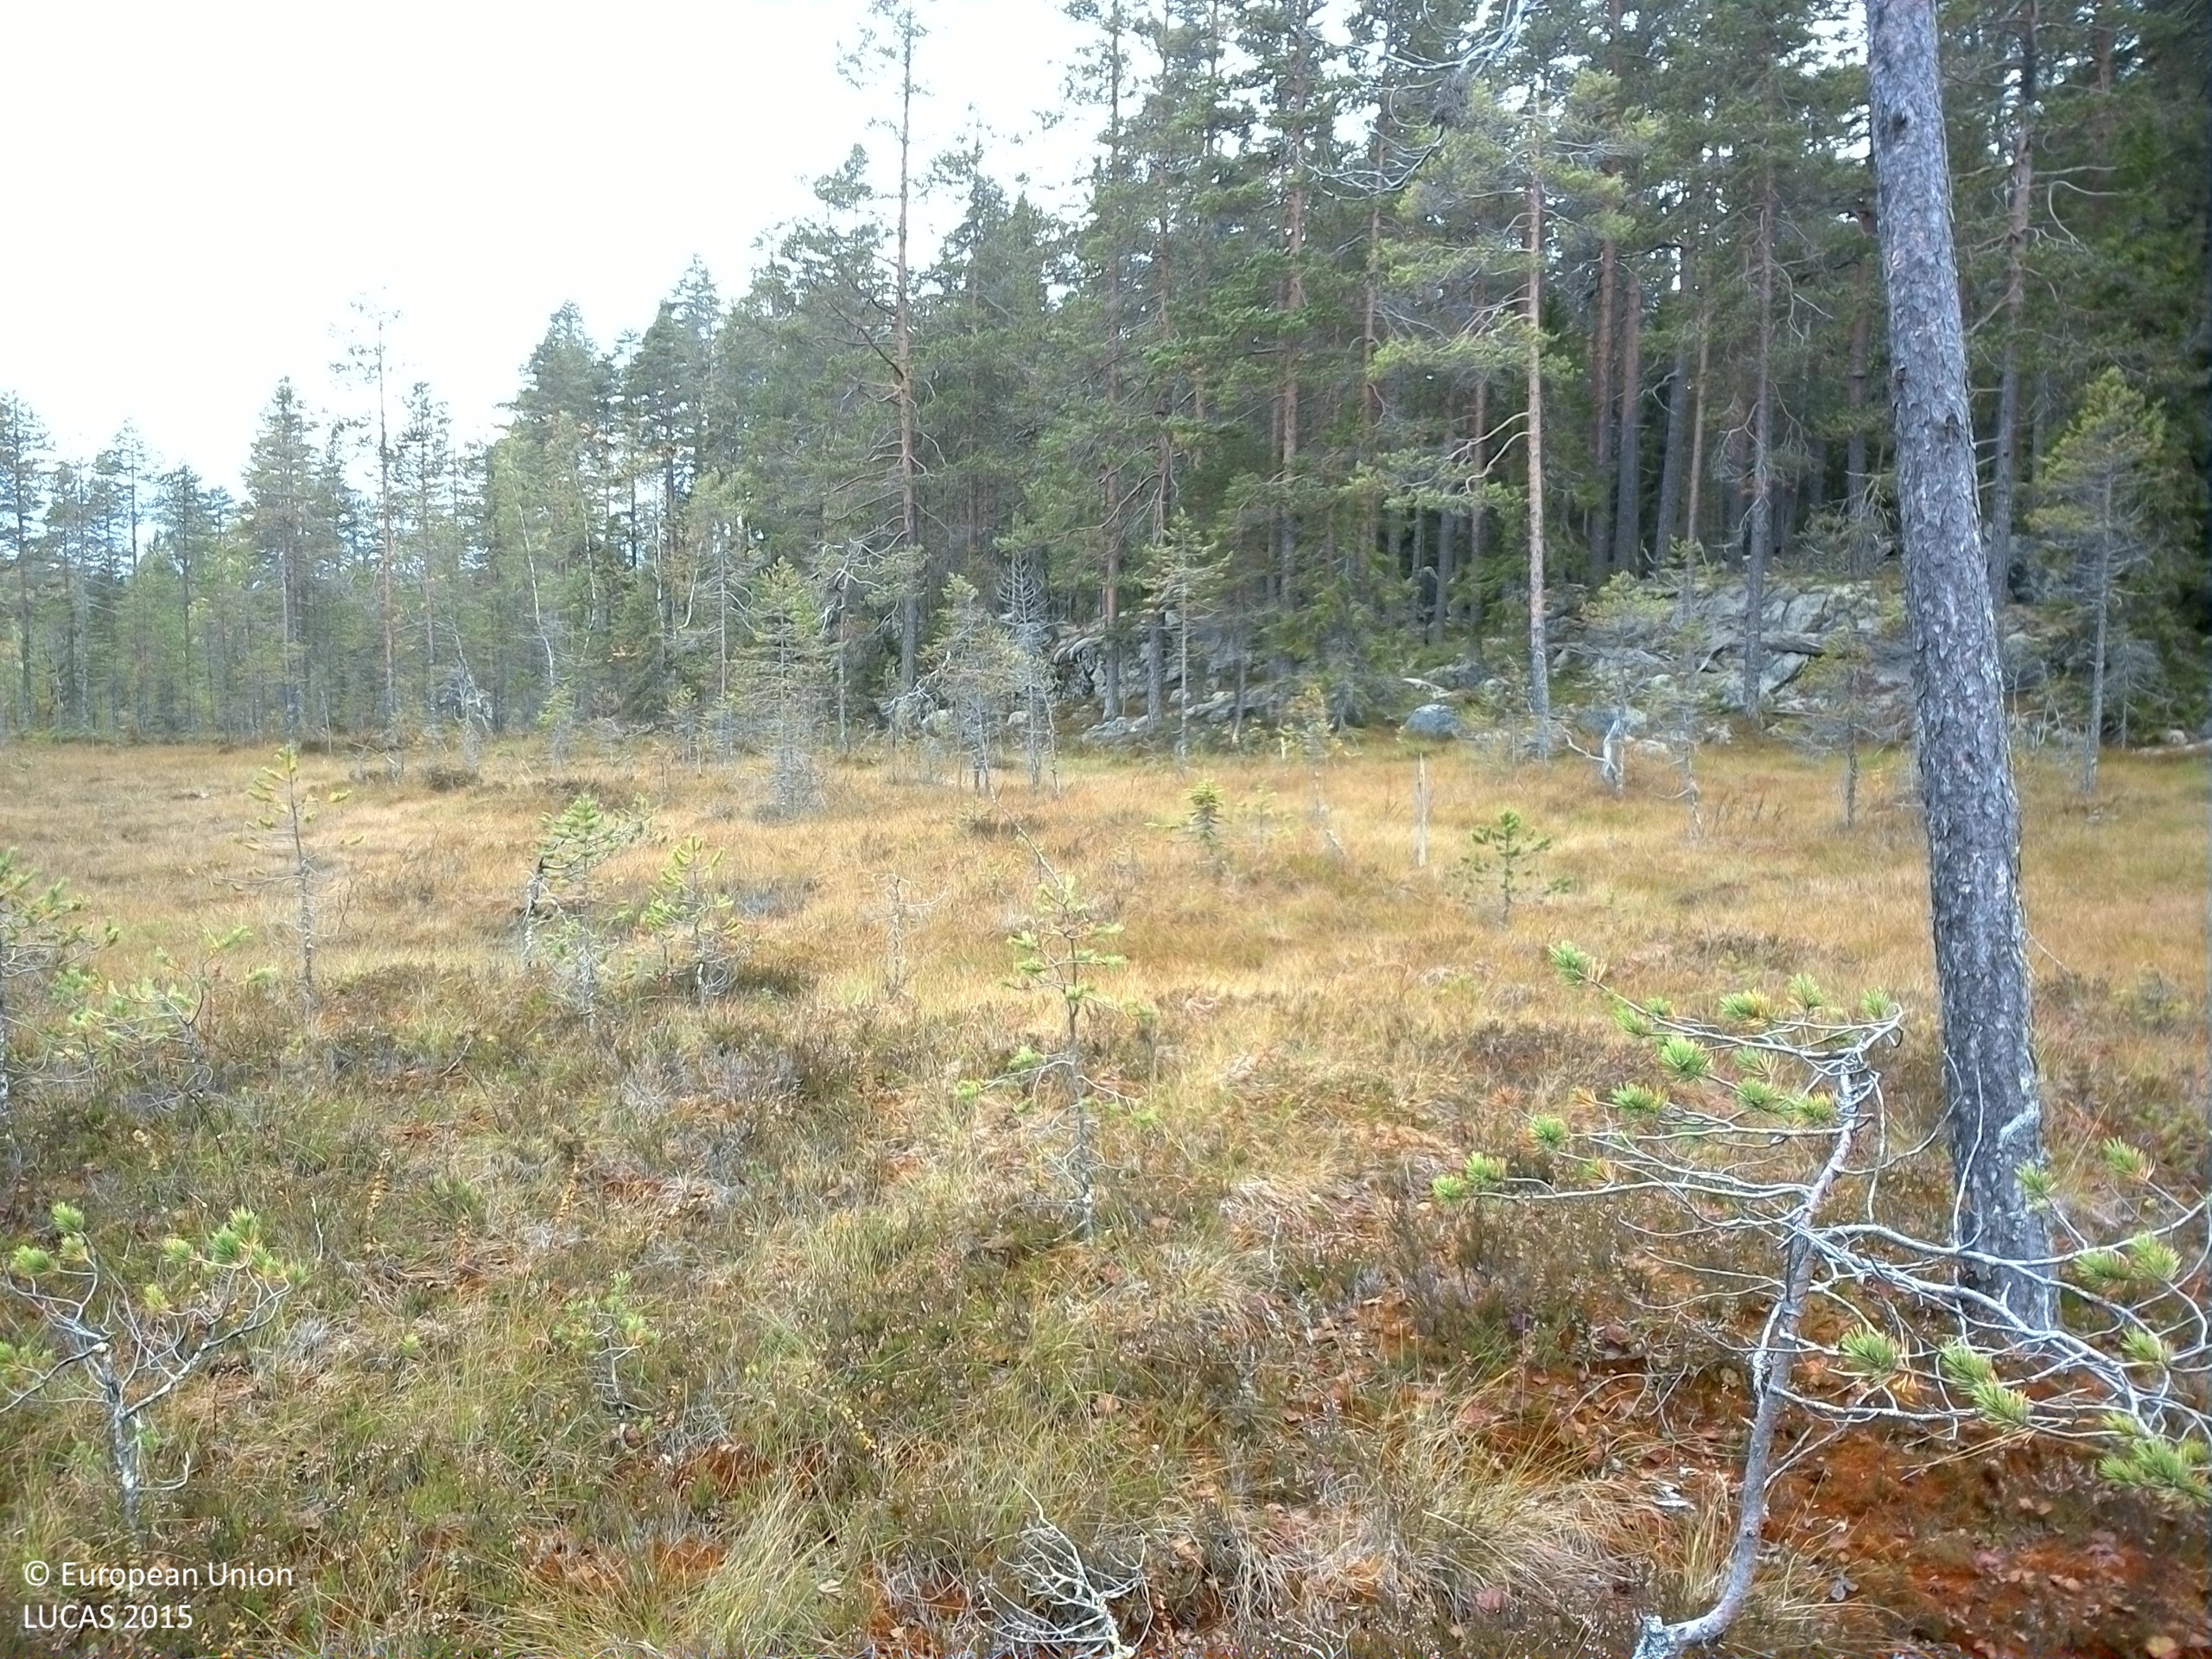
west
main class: Woodland
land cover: Pine dominated coniferous woodland
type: mire and swamp forests
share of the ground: 10 - 25 %
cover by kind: shrubs 40 %, lichens and mosses 40 %, coniferous forest trees 20 %
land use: Semi-natural and natural areas not in use
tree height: < 5 m
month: September
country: SE
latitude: 61.5344
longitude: 15.0434
